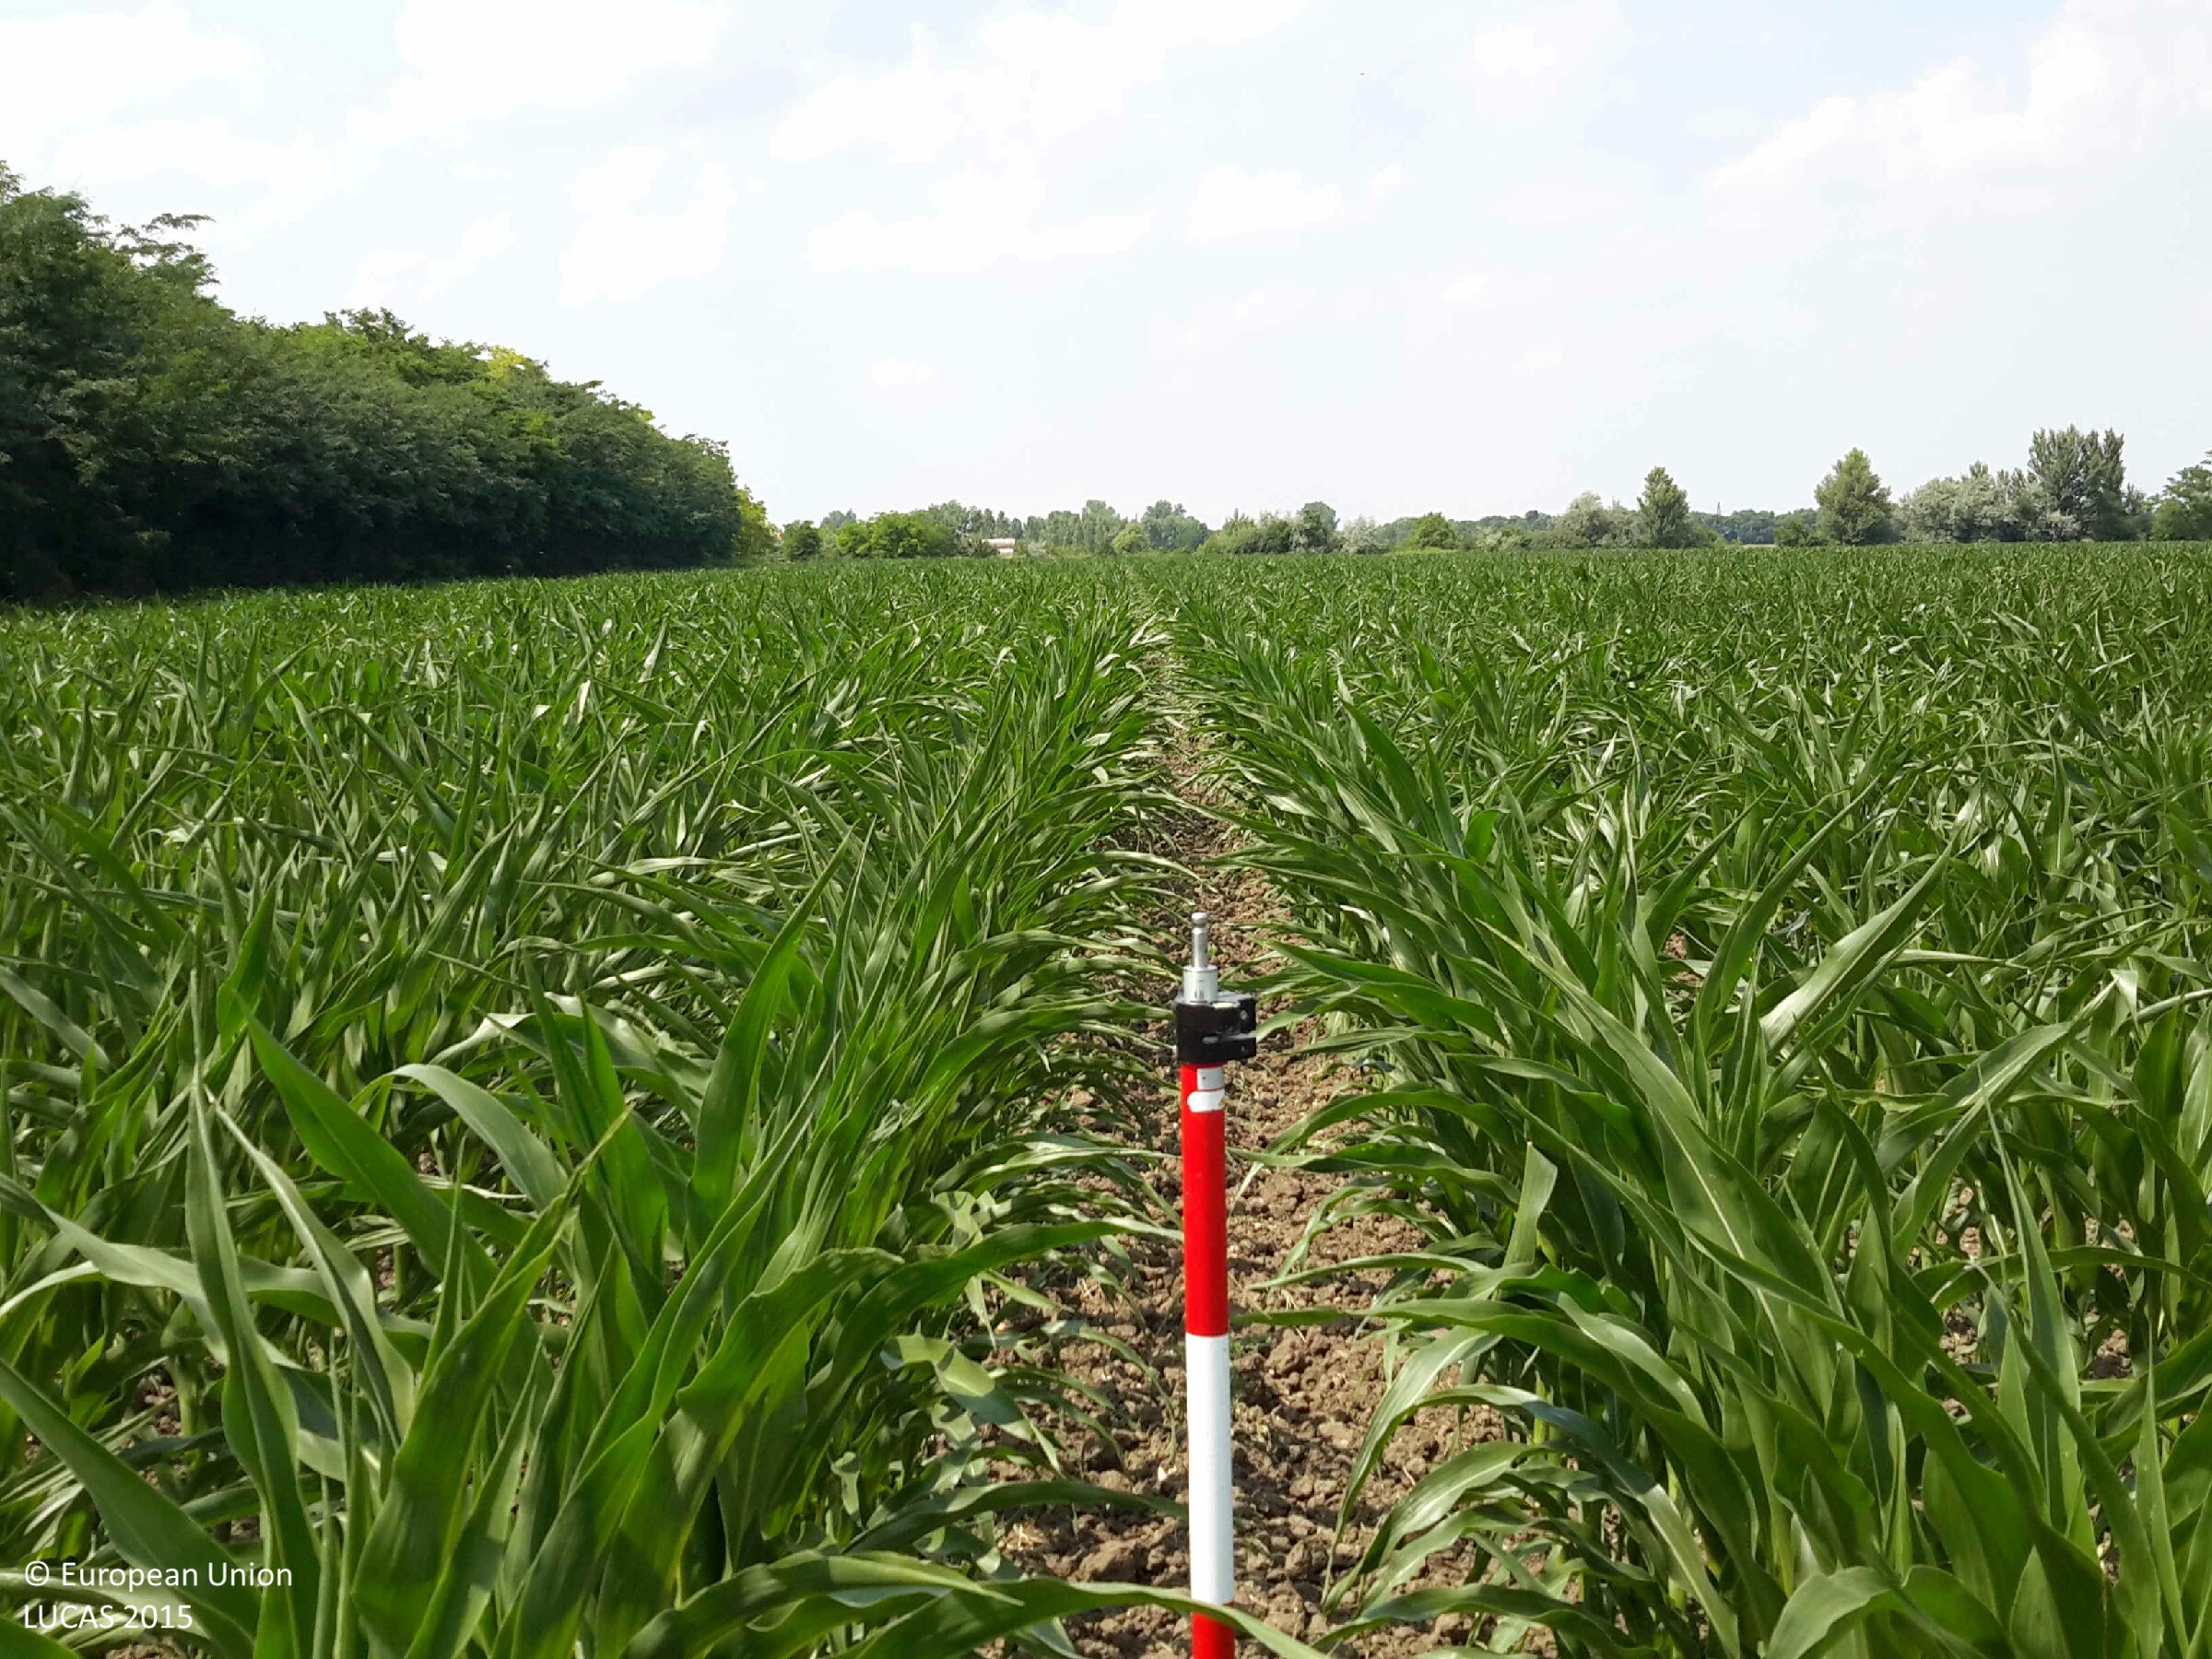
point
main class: Cropland
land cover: Maize
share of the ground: 50 - 75 %
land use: Agriculture (excluding fallow land and kitchen gardens)
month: July
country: HU
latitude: 47.3615
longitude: 17.3820
